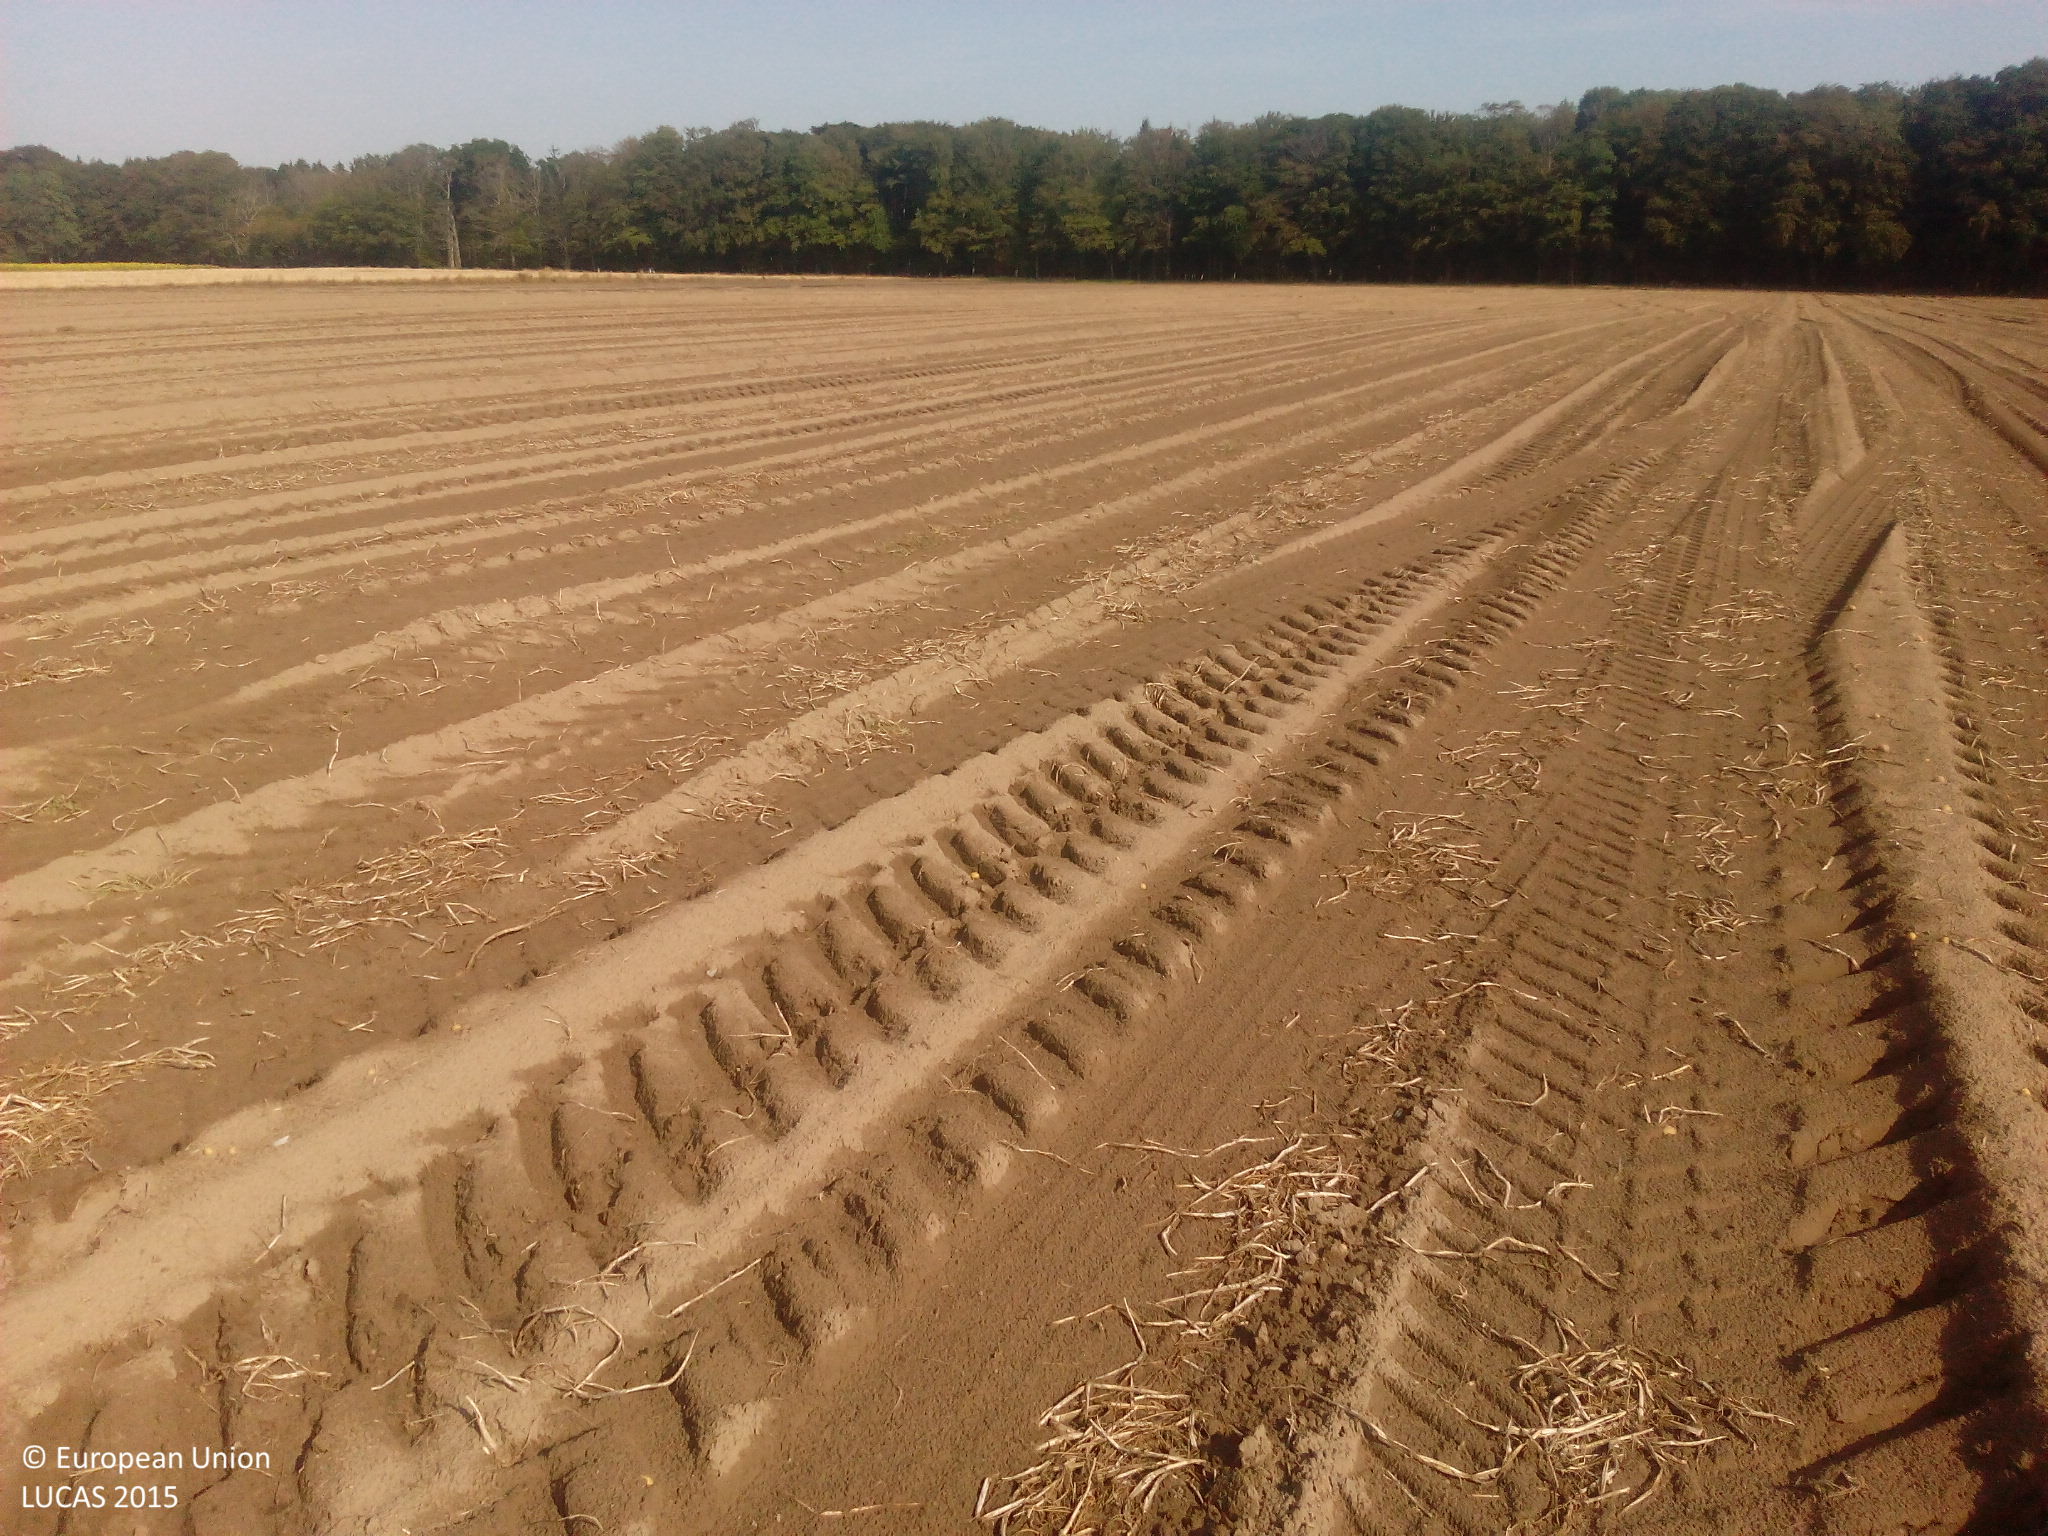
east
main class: Cropland
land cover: Potatoes
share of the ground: < 10 %
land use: Agriculture (excluding fallow land and kitchen gardens)
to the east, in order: Potatoes
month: August
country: DE
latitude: 54.1809
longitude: 12.7111
